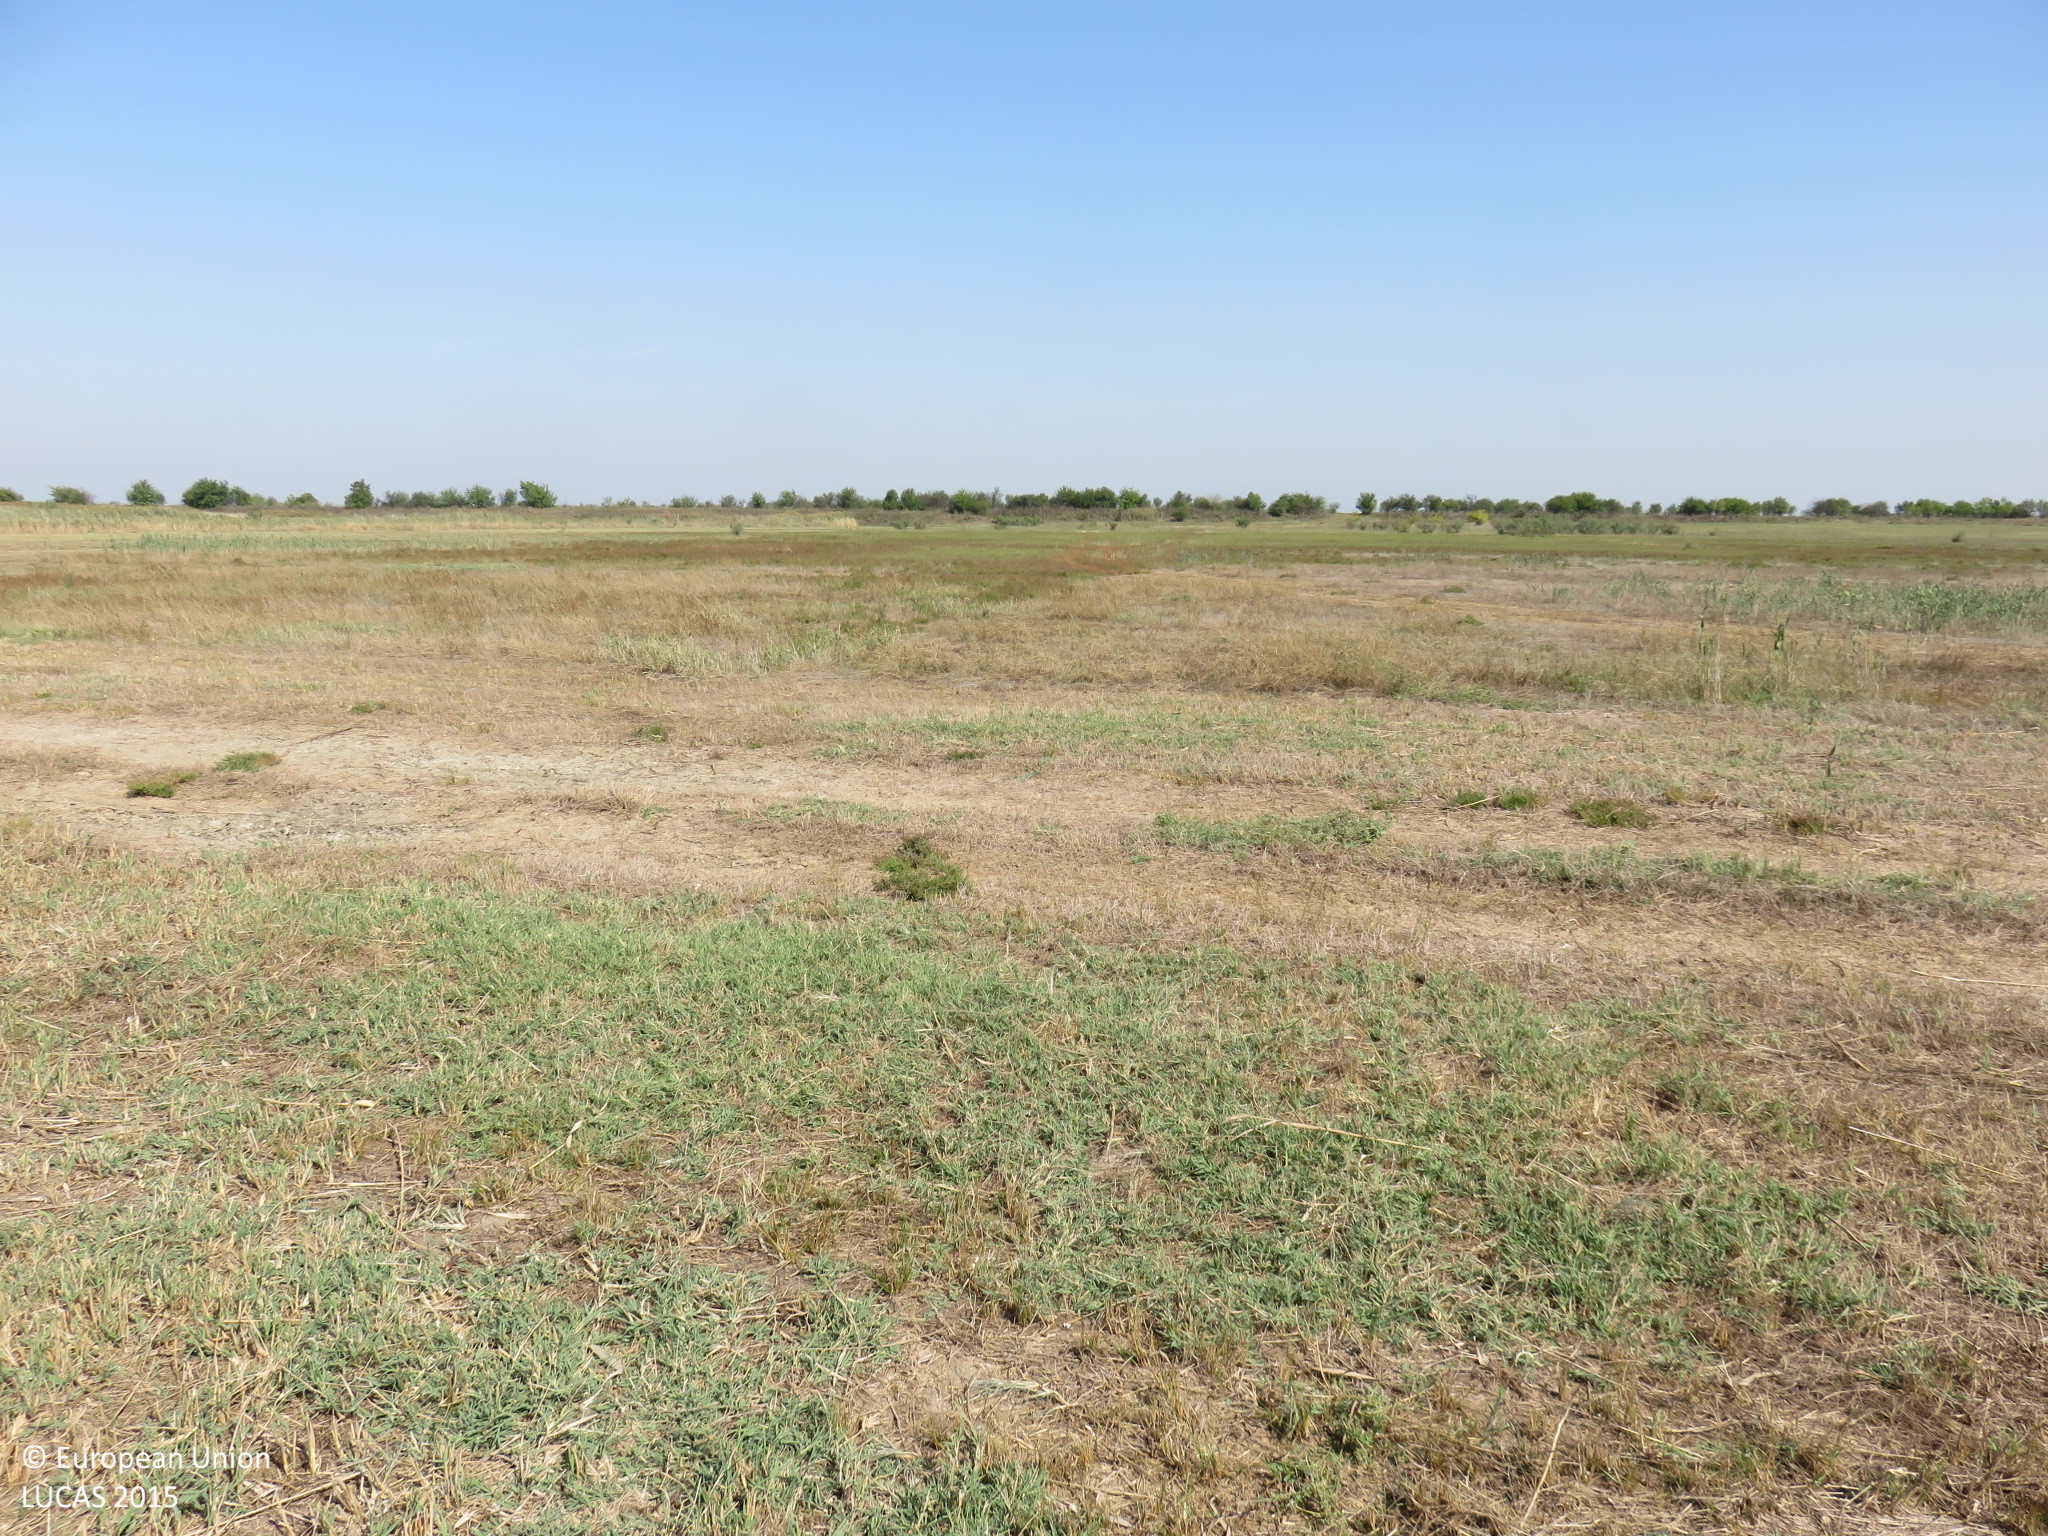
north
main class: Grassland
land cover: Grassland without tree/shrub cover
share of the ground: > 75 %
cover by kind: herbaceous plants 100 %
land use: Agriculture (excluding fallow land and kitchen gardens)
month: September
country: BG
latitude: 43.7177
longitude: 24.5750
